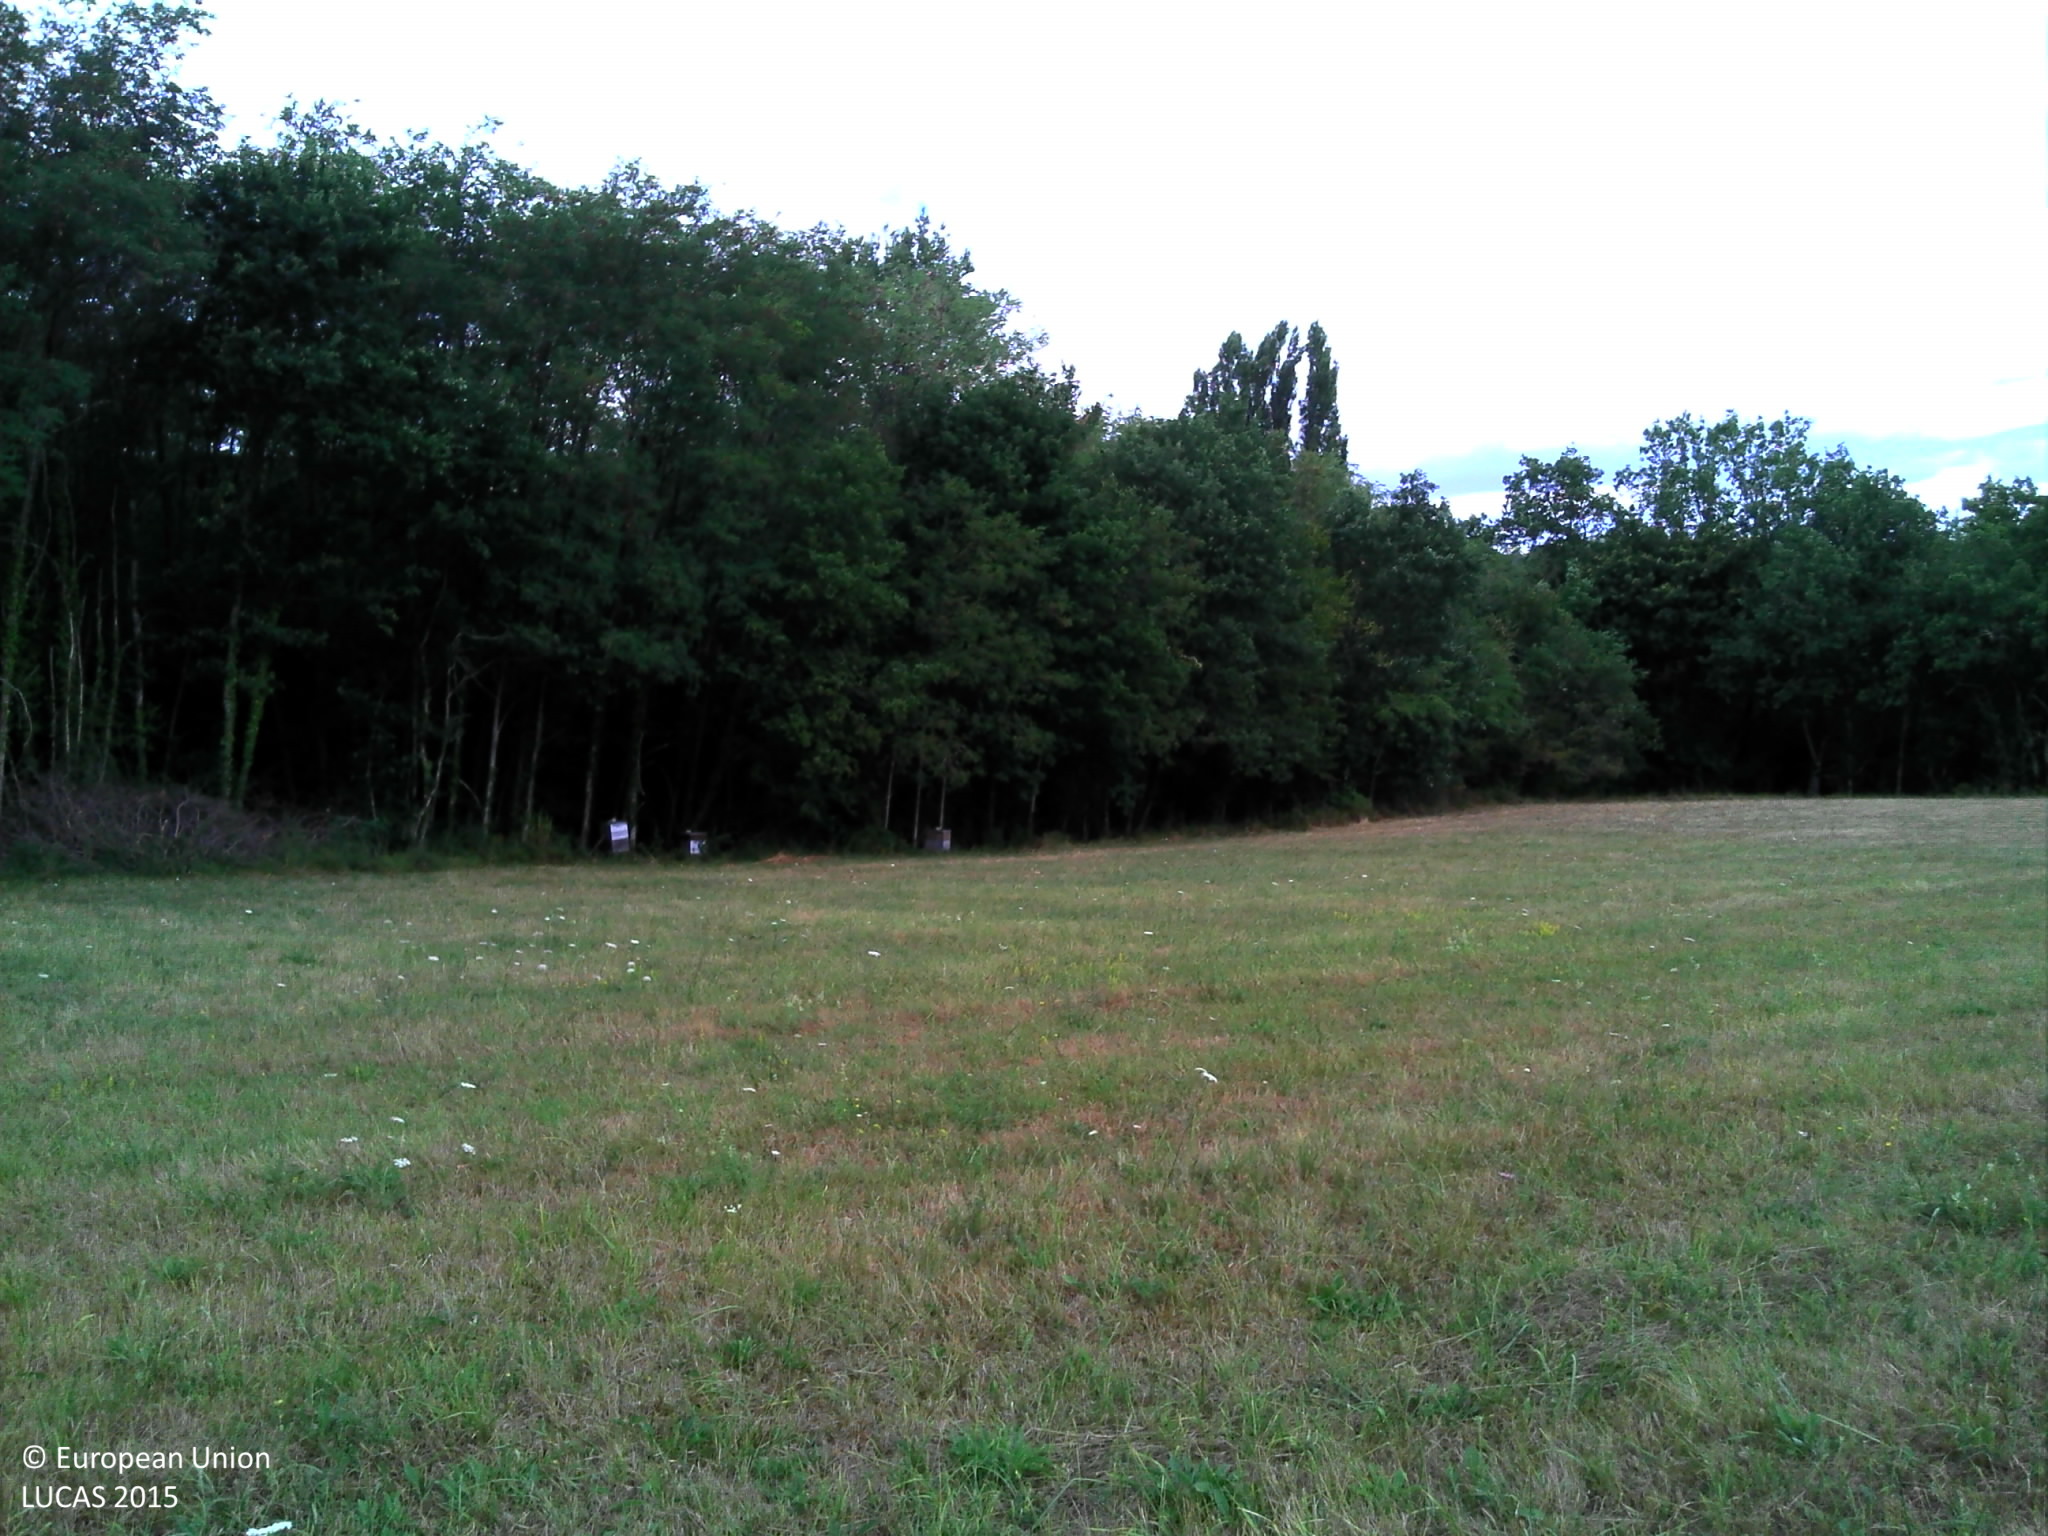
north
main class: Grassland
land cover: Grassland without tree/shrub cover
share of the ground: > 75 %
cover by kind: herbaceous plants 100 %
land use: Agriculture (excluding fallow land and kitchen gardens)
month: July
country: FR
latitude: 44.8965
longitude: 0.9389
